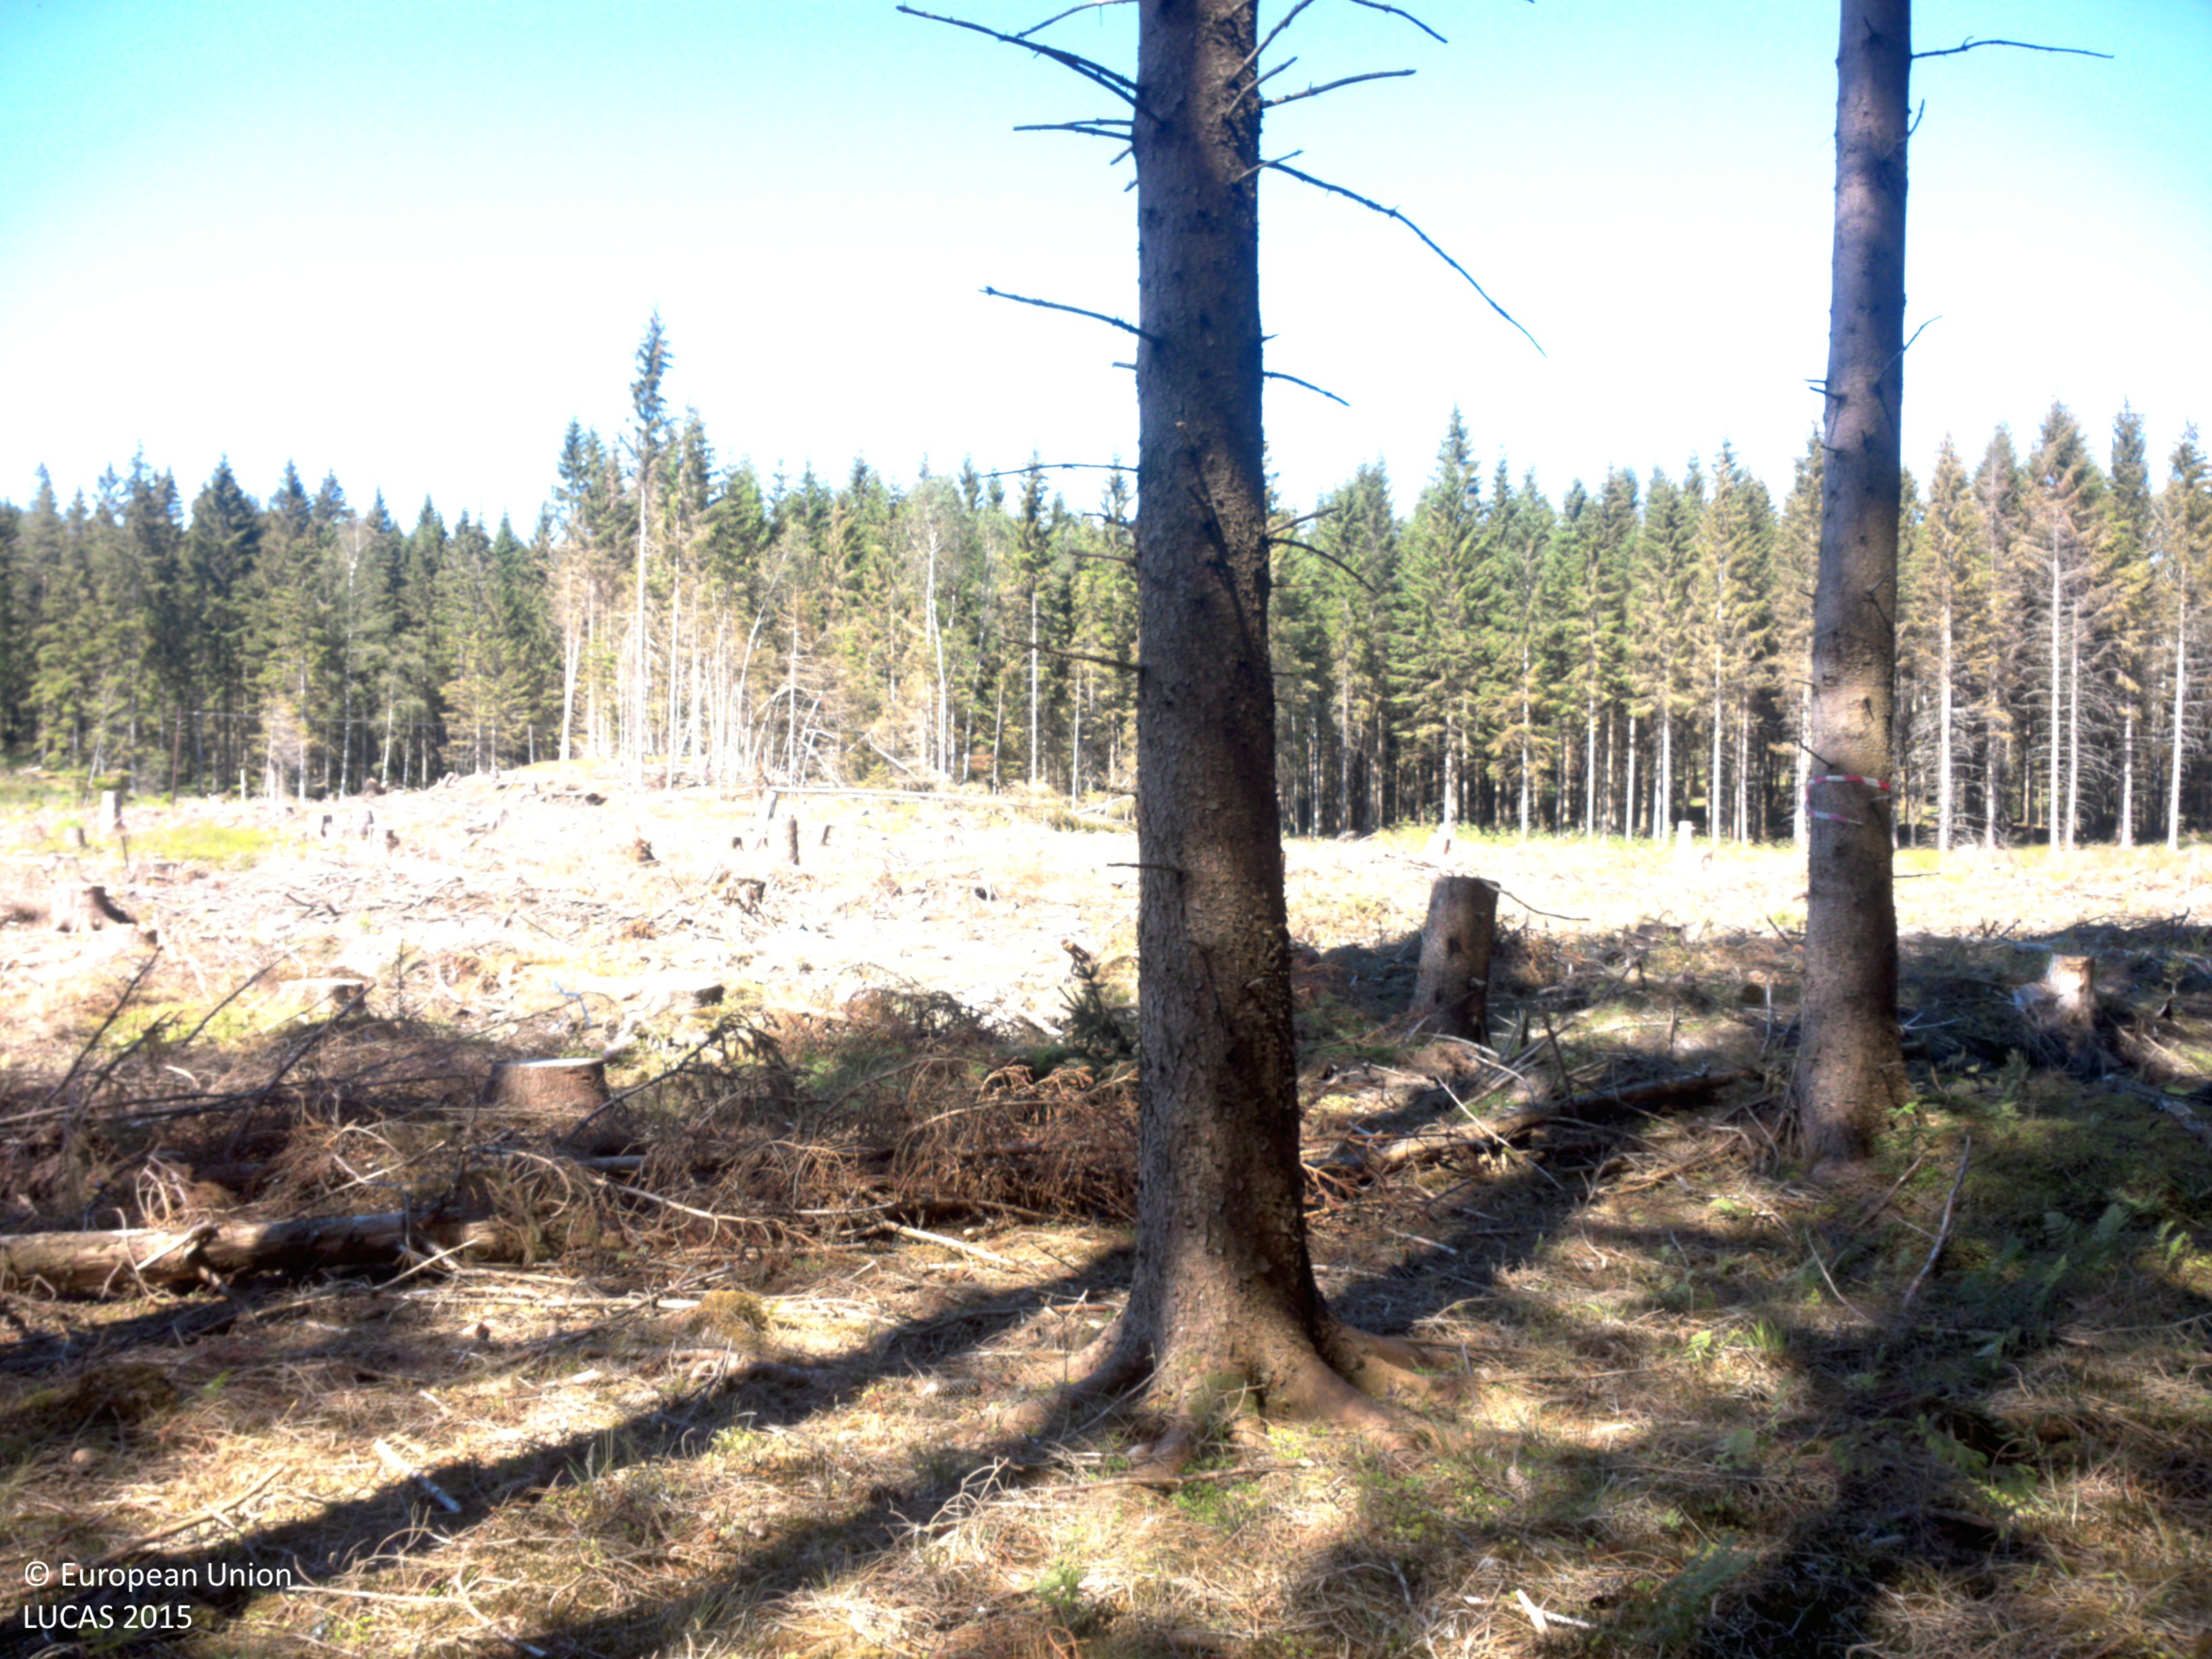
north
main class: Woodland
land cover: Spruce dominated coniferous woodland
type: boreal forest
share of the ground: 50 - 75 %
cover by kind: coniferous forest trees 50 %, lichens and mosses 50 %
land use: Forestry
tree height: > 5 m
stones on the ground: < 10 %
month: July
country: SE
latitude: 58.4755
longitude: 11.9336
